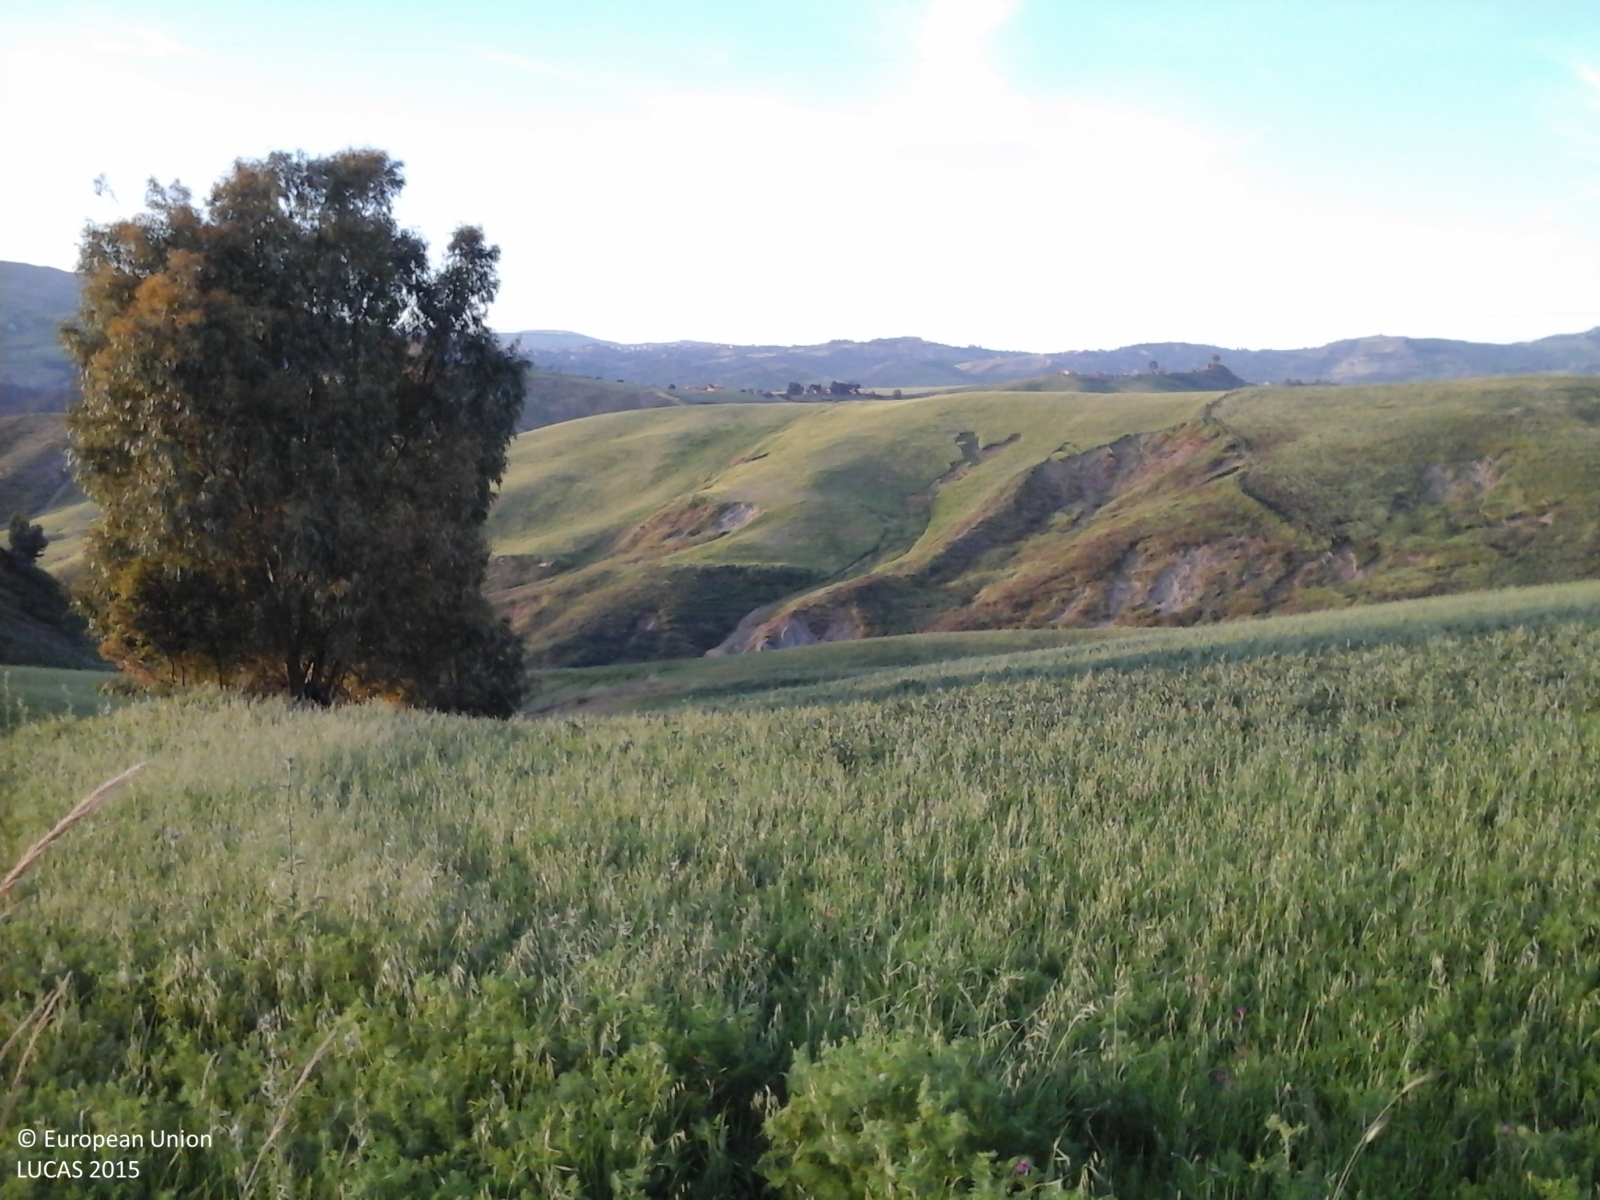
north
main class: Cropland
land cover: Other leguminous and mixtures for fodder
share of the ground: > 75 %
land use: Agriculture (excluding fallow land and kitchen gardens)
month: May
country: IT
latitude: 37.5348
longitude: 14.0327
